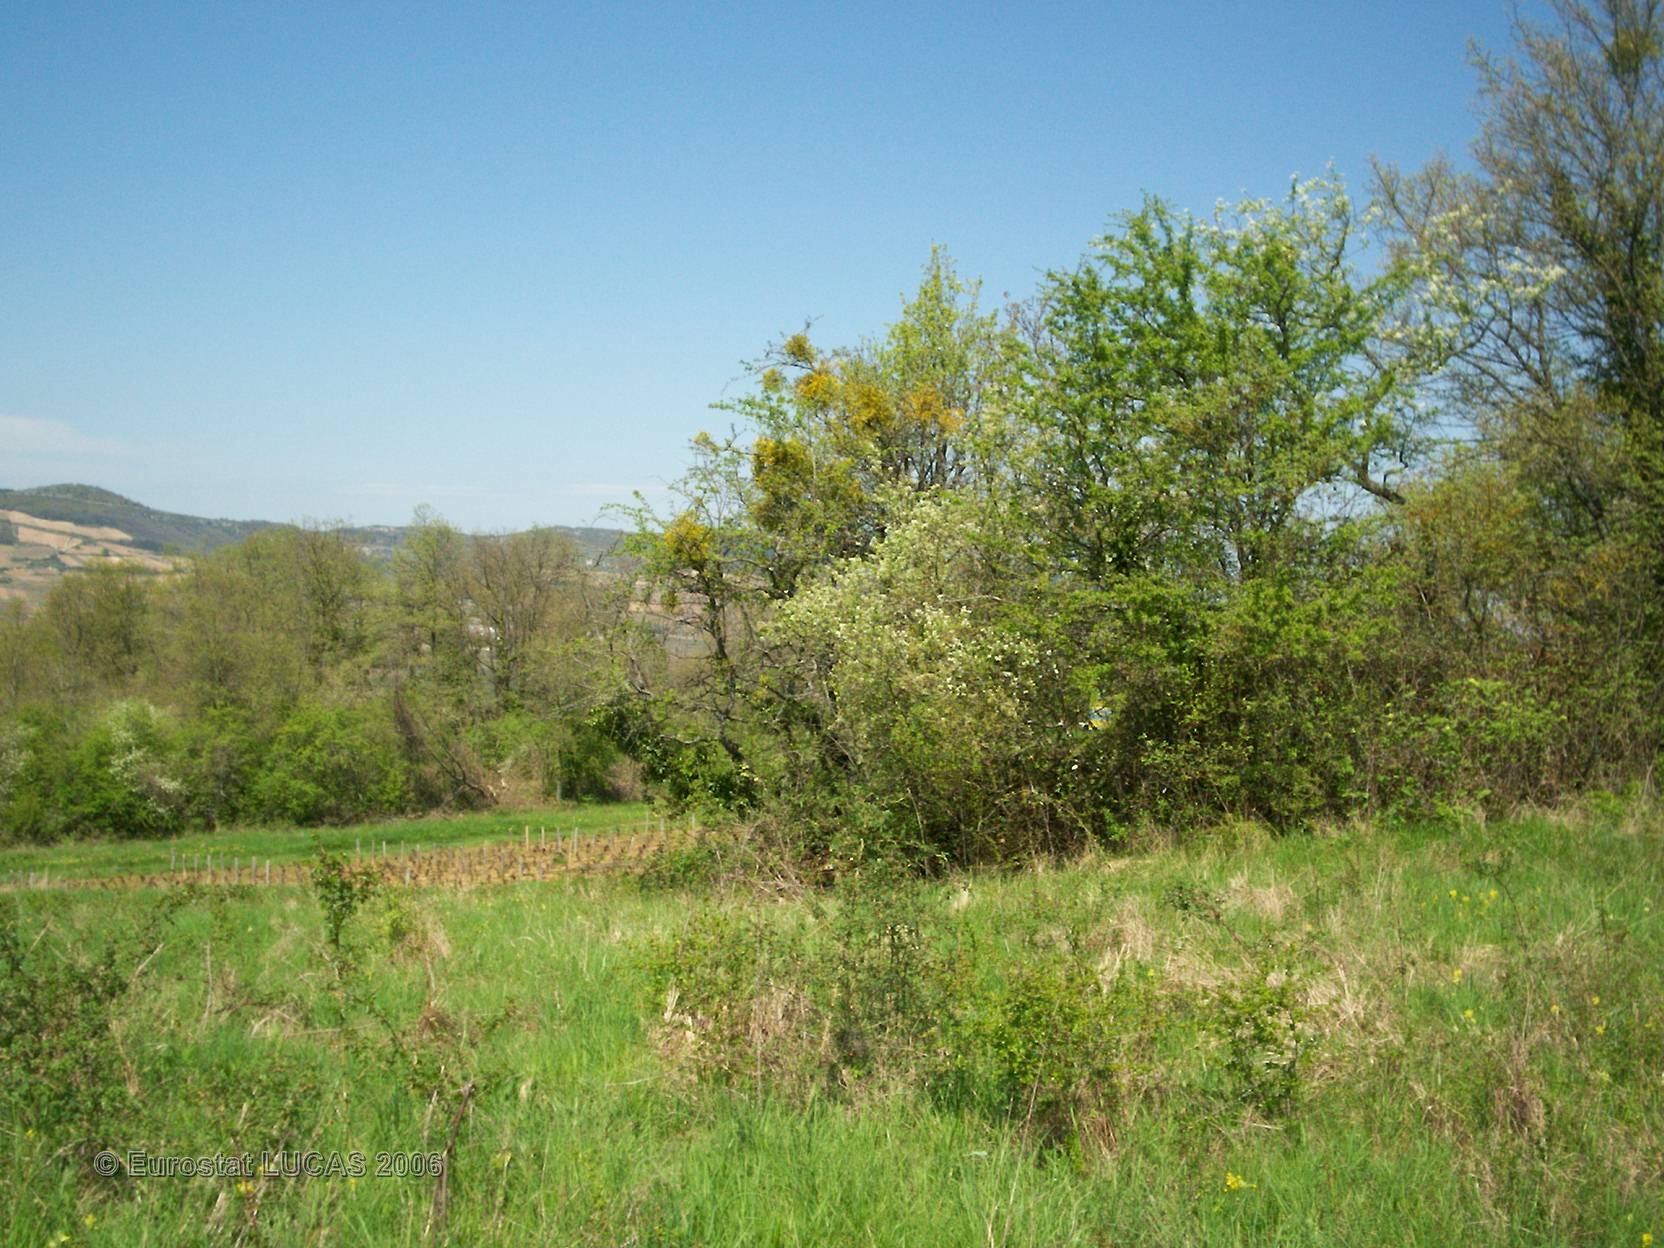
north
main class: Grassland
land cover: Grassland without tree/shrub cover
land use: Unused
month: April
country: FR
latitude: 46.8869
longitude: 4.6858
